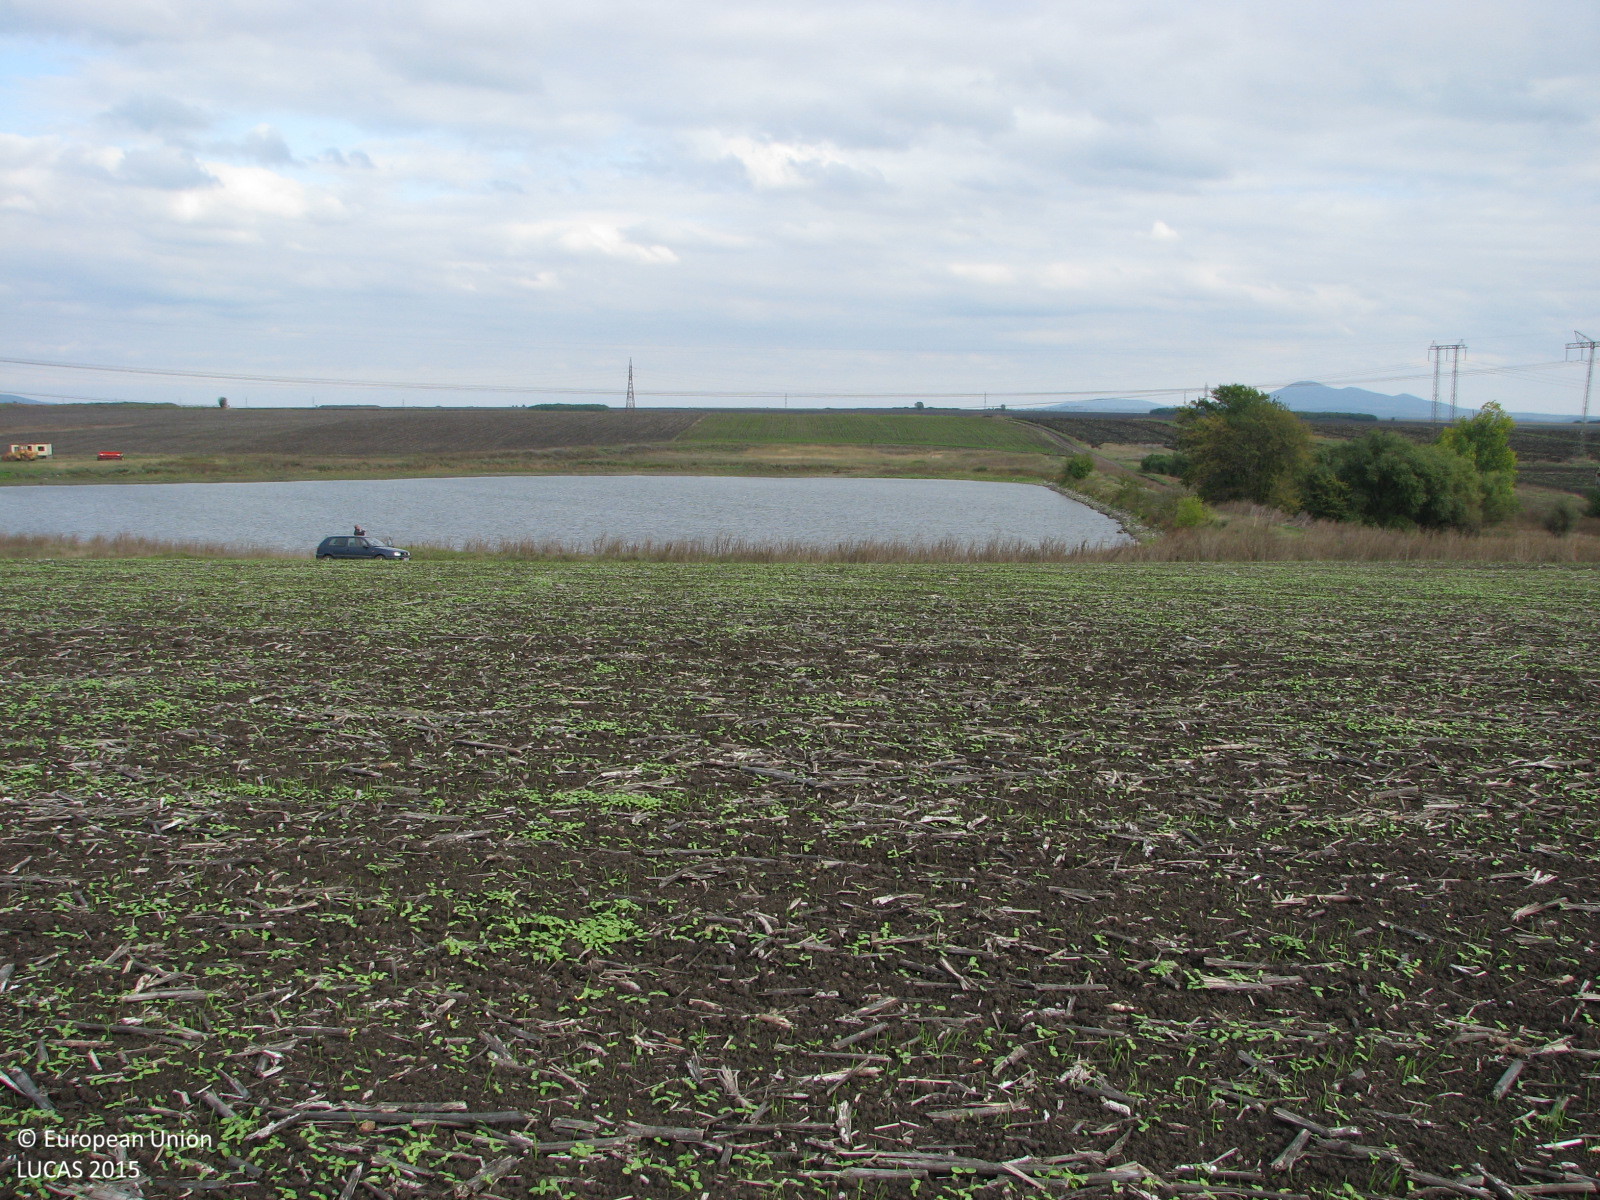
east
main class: Cropland
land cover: Sunflower
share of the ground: < 10 %
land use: Agriculture (excluding fallow land and kitchen gardens)
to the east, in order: Sunflower; Grass margins; Tracks; Grassland without tree/shrub cover; Inland fresh water bodies
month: October
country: BG
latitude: 42.2892
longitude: 26.1261
